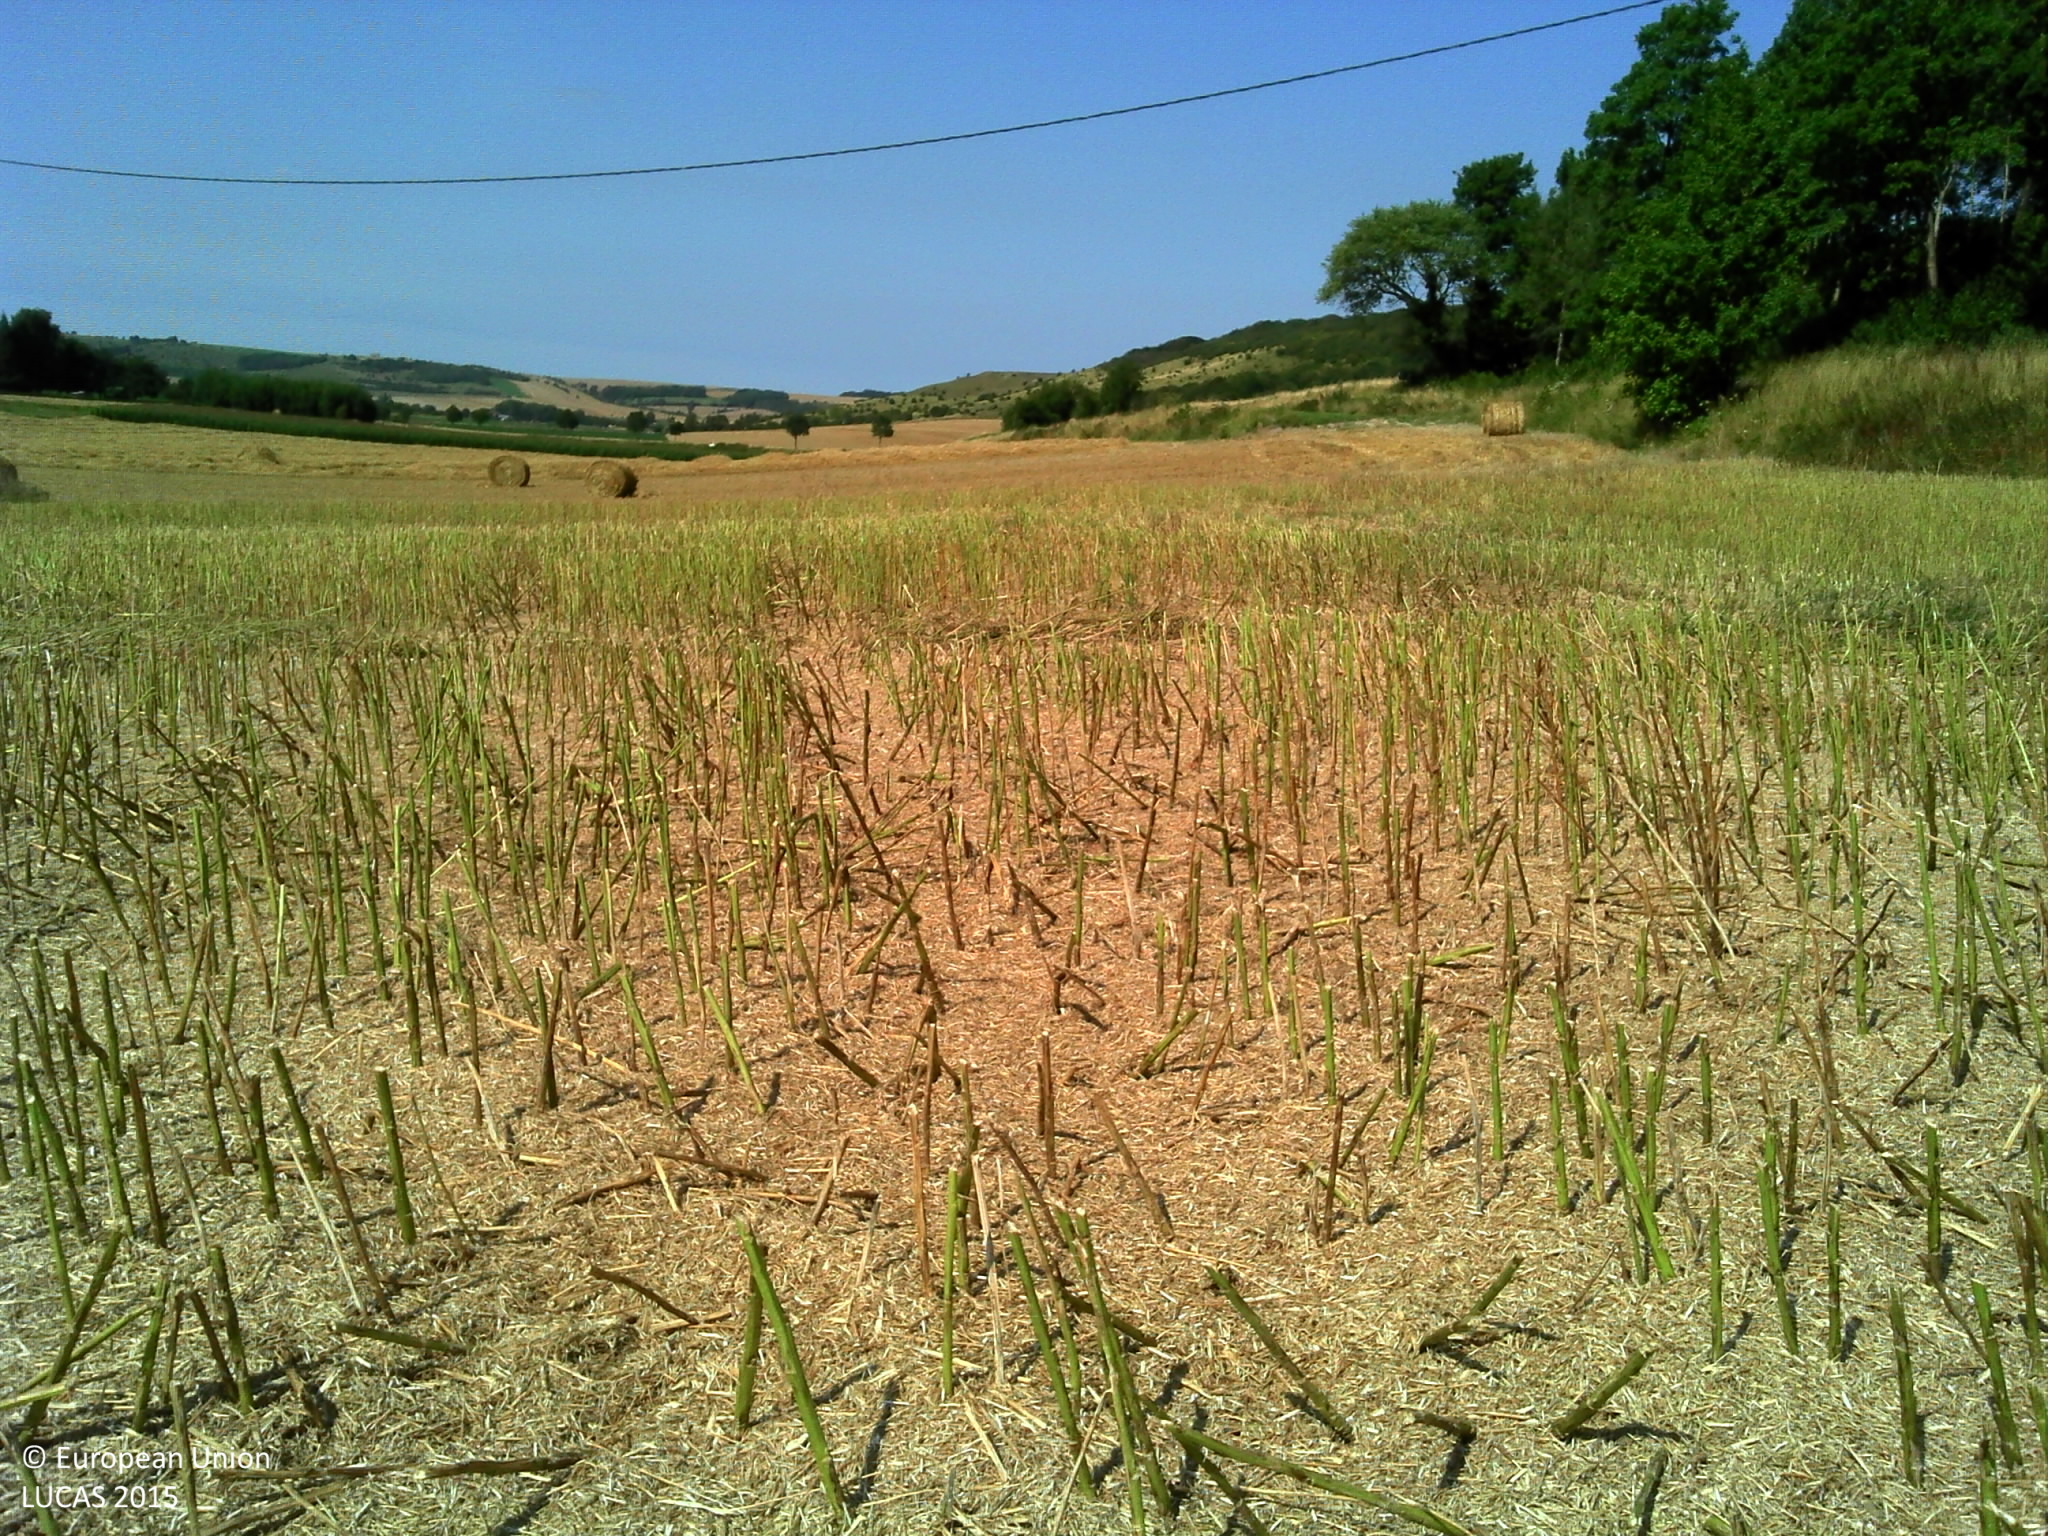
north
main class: Cropland
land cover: Rape and turnip rape
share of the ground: 25 - 50 %
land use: Agriculture (excluding fallow land and kitchen gardens)
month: August
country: FR
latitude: 50.7723
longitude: 2.0293
